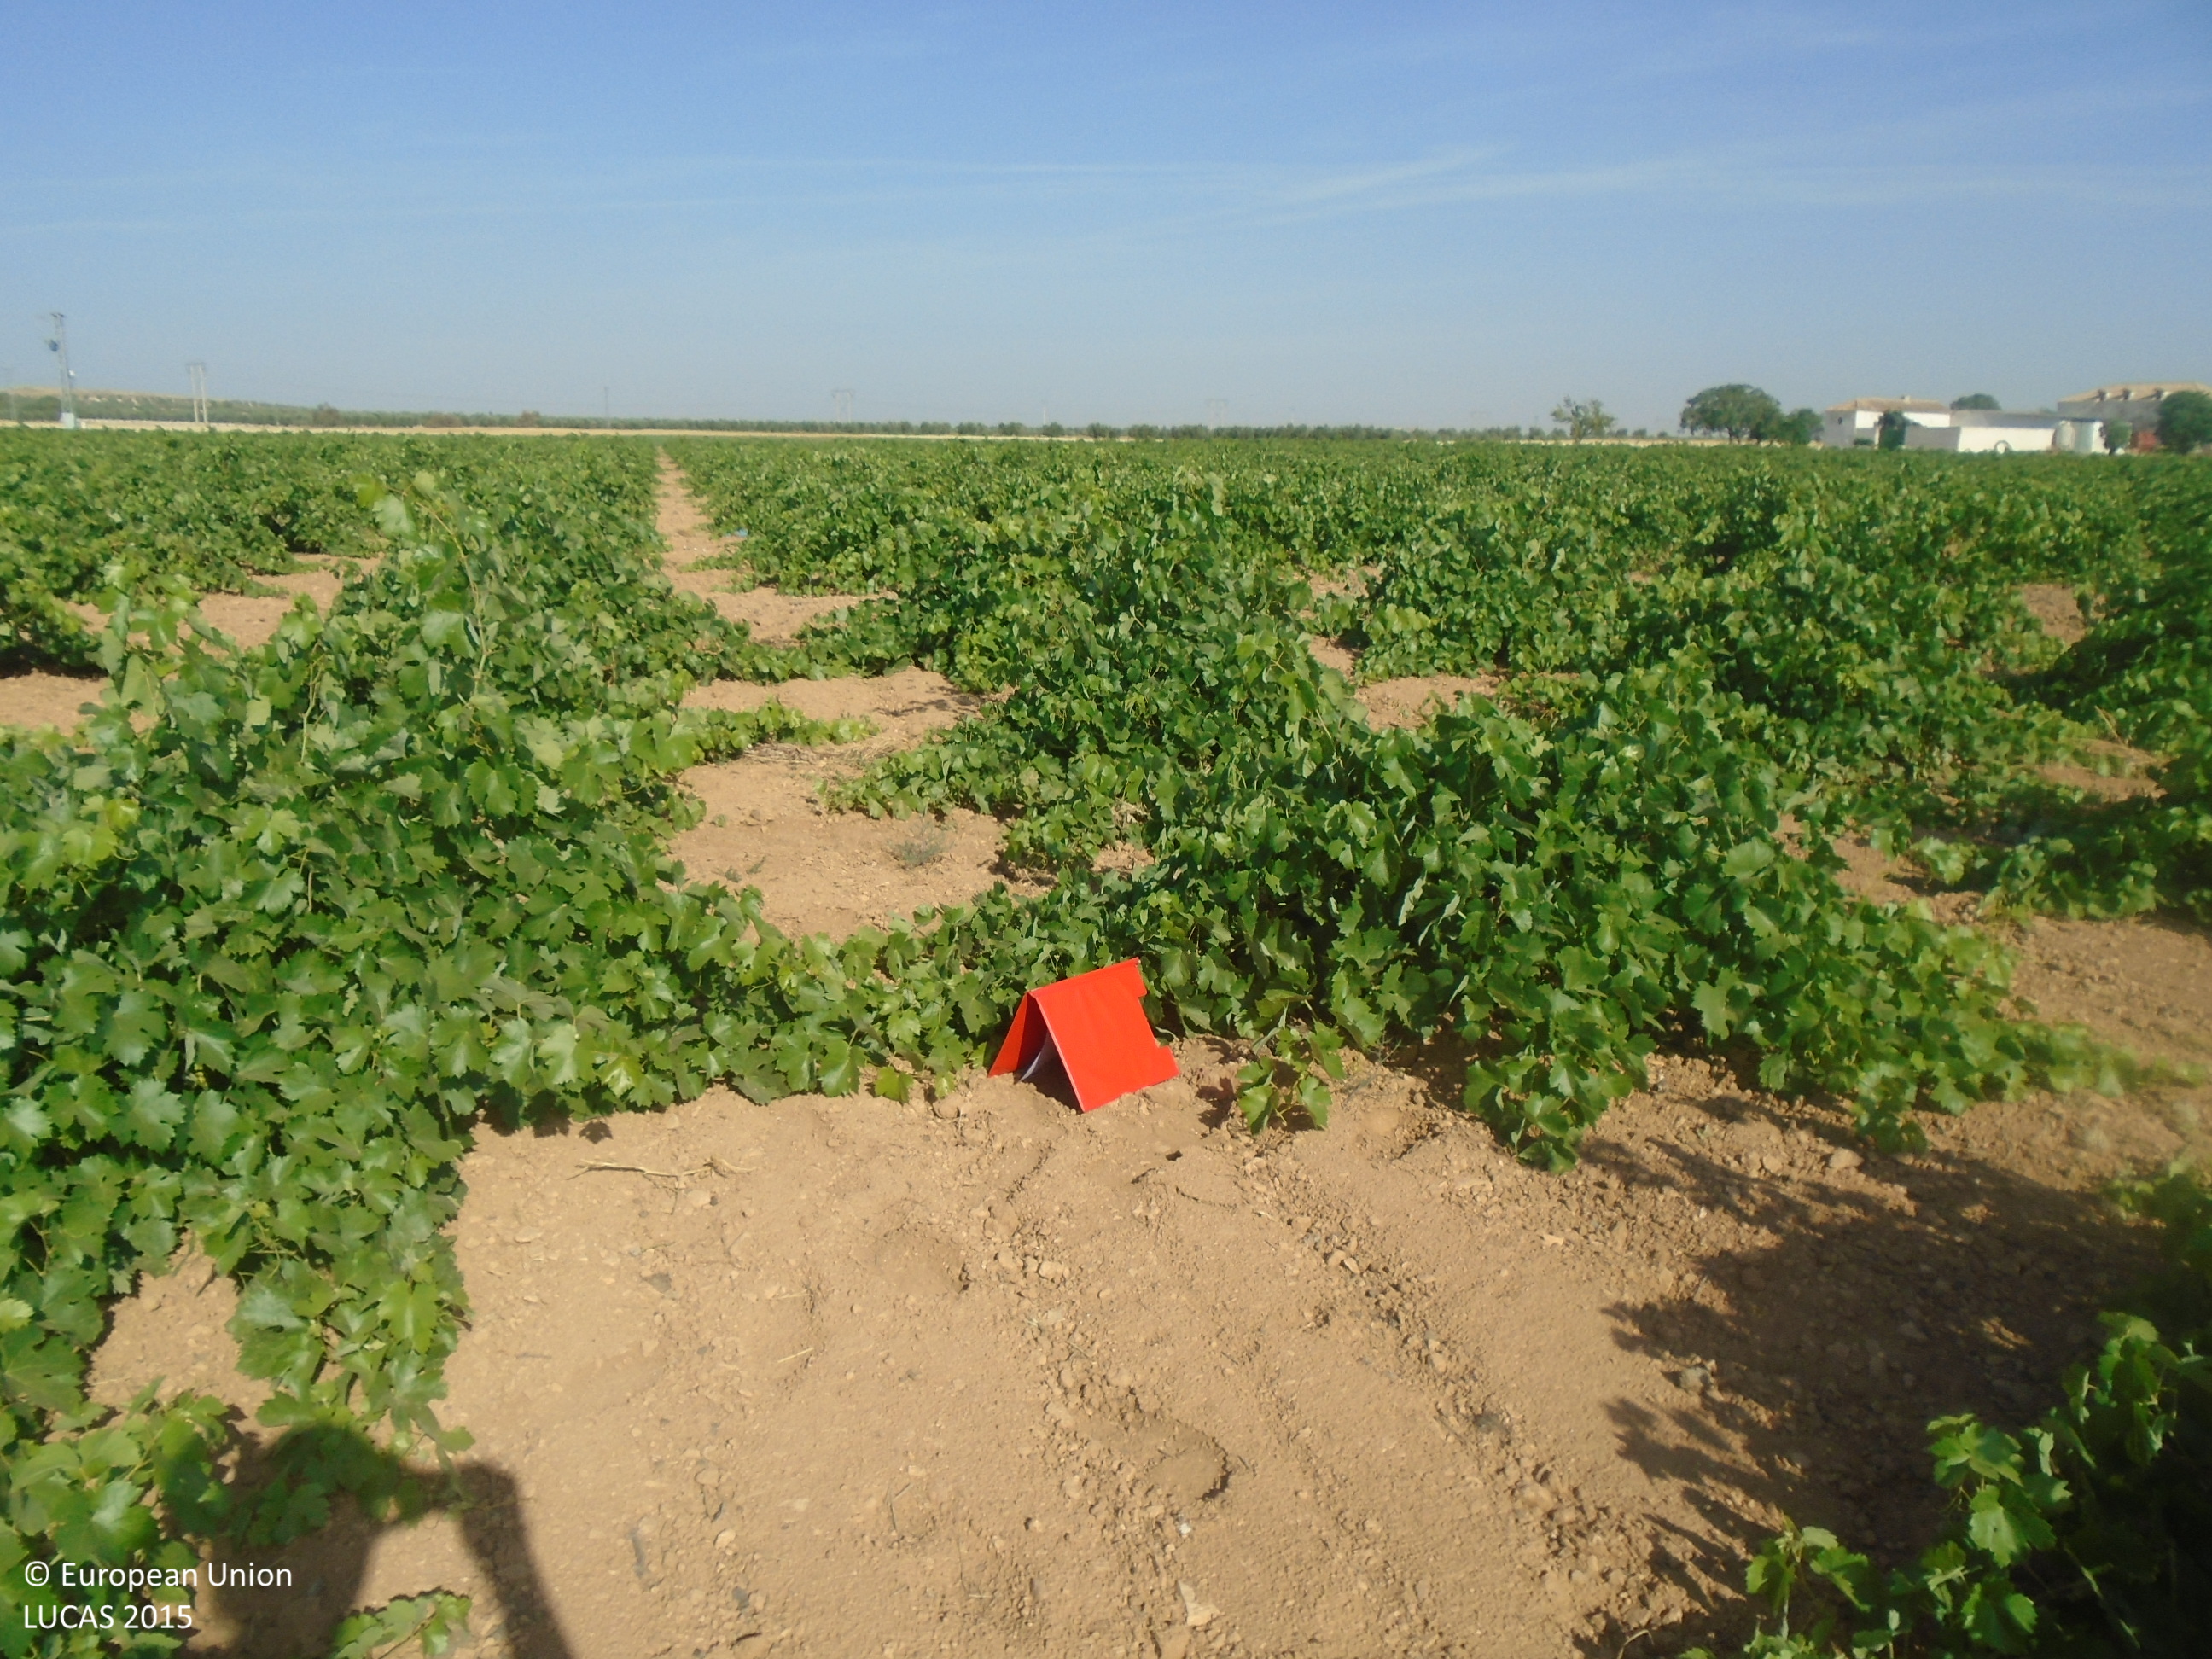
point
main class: Cropland
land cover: Vineyards
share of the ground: 10 - 25 %
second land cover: Other bare soil
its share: > 75 %
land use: Agriculture (excluding fallow land and kitchen gardens)
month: July
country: ES
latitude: 39.3991
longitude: -3.5266
